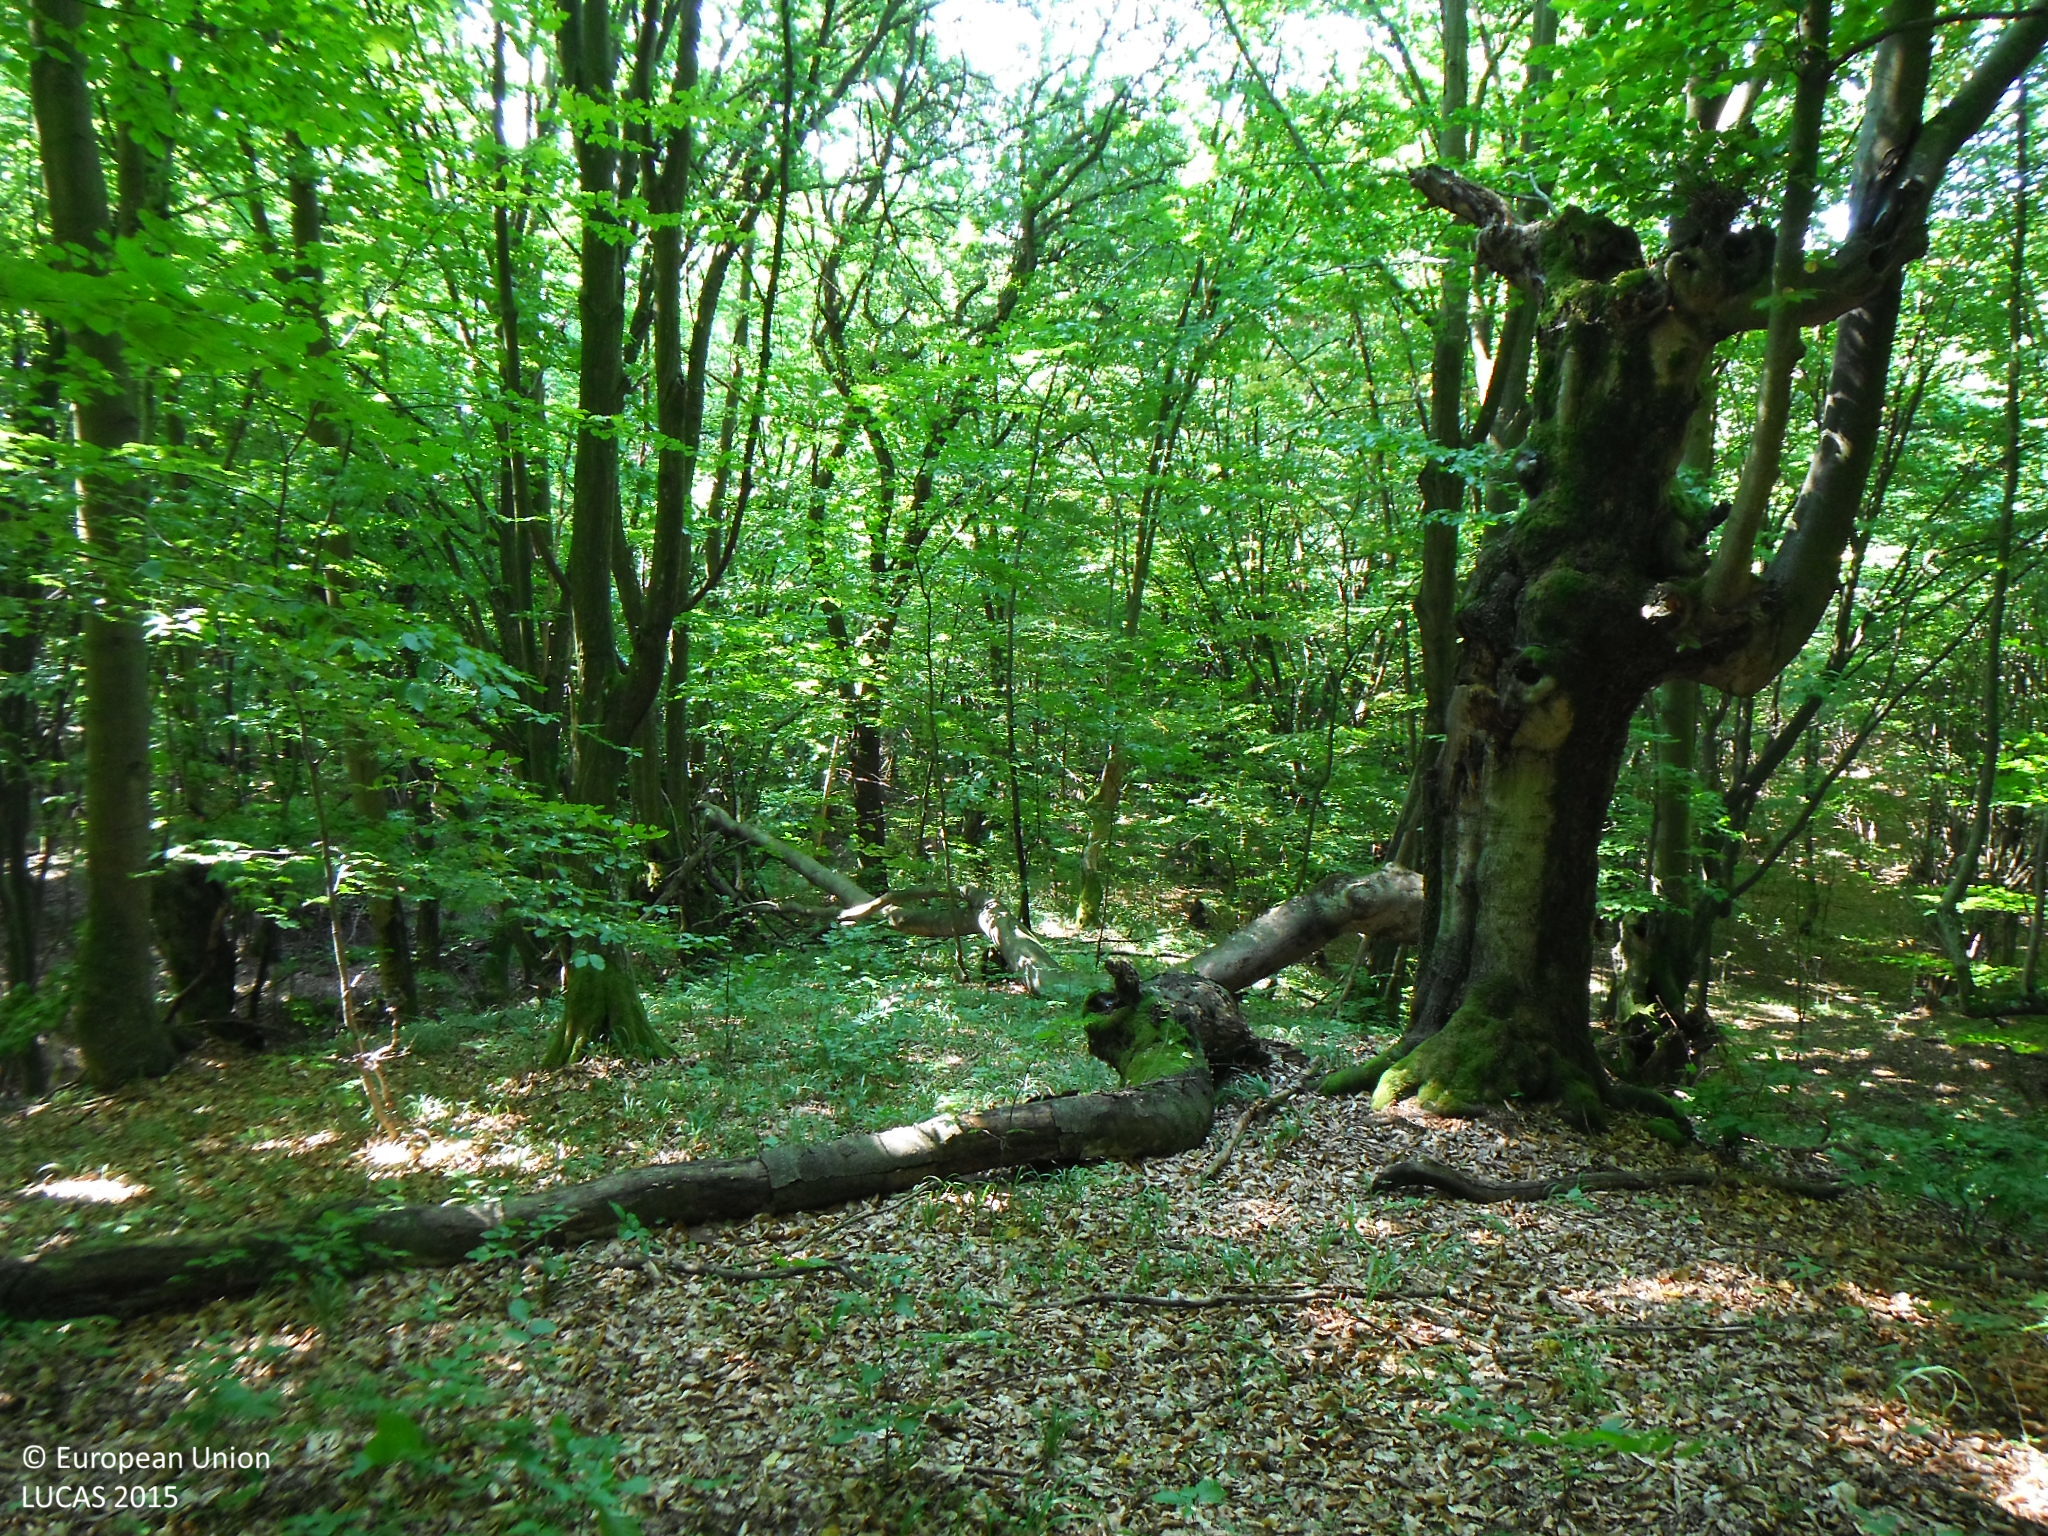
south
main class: Woodland
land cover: Broadleaved woodland
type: hemiboreal forest and nemoral coniferous forest and mixed broadleaved-coniferous forest
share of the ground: > 75 %
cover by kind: broadleaved forest trees 85 %, coniferous forest trees 15 %
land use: Forestry
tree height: > 5 m
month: August
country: SK
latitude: 49.1155
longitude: 21.9611
